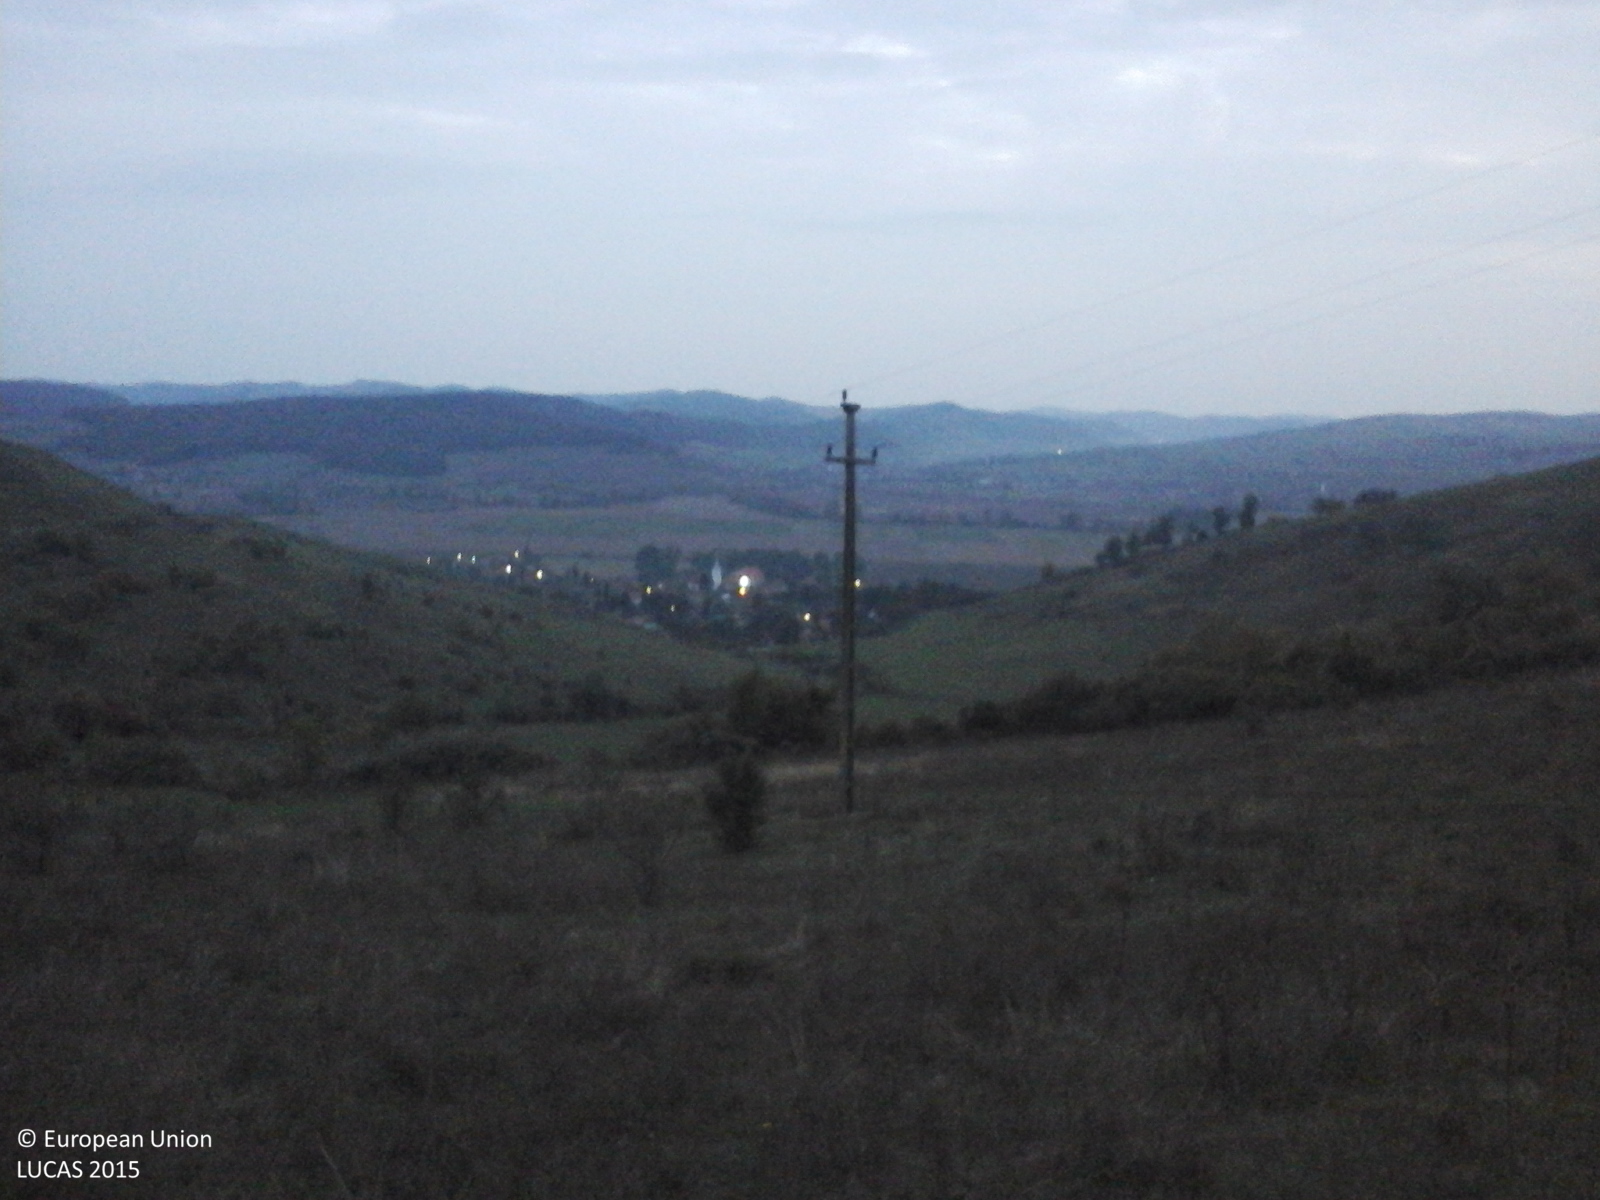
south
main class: Grassland
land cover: Grassland without tree/shrub cover
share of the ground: > 75 %
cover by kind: herbaceous plants 100 %
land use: Agriculture (excluding fallow land and kitchen gardens)
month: October
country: RO
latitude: 46.4224
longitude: 24.7292
